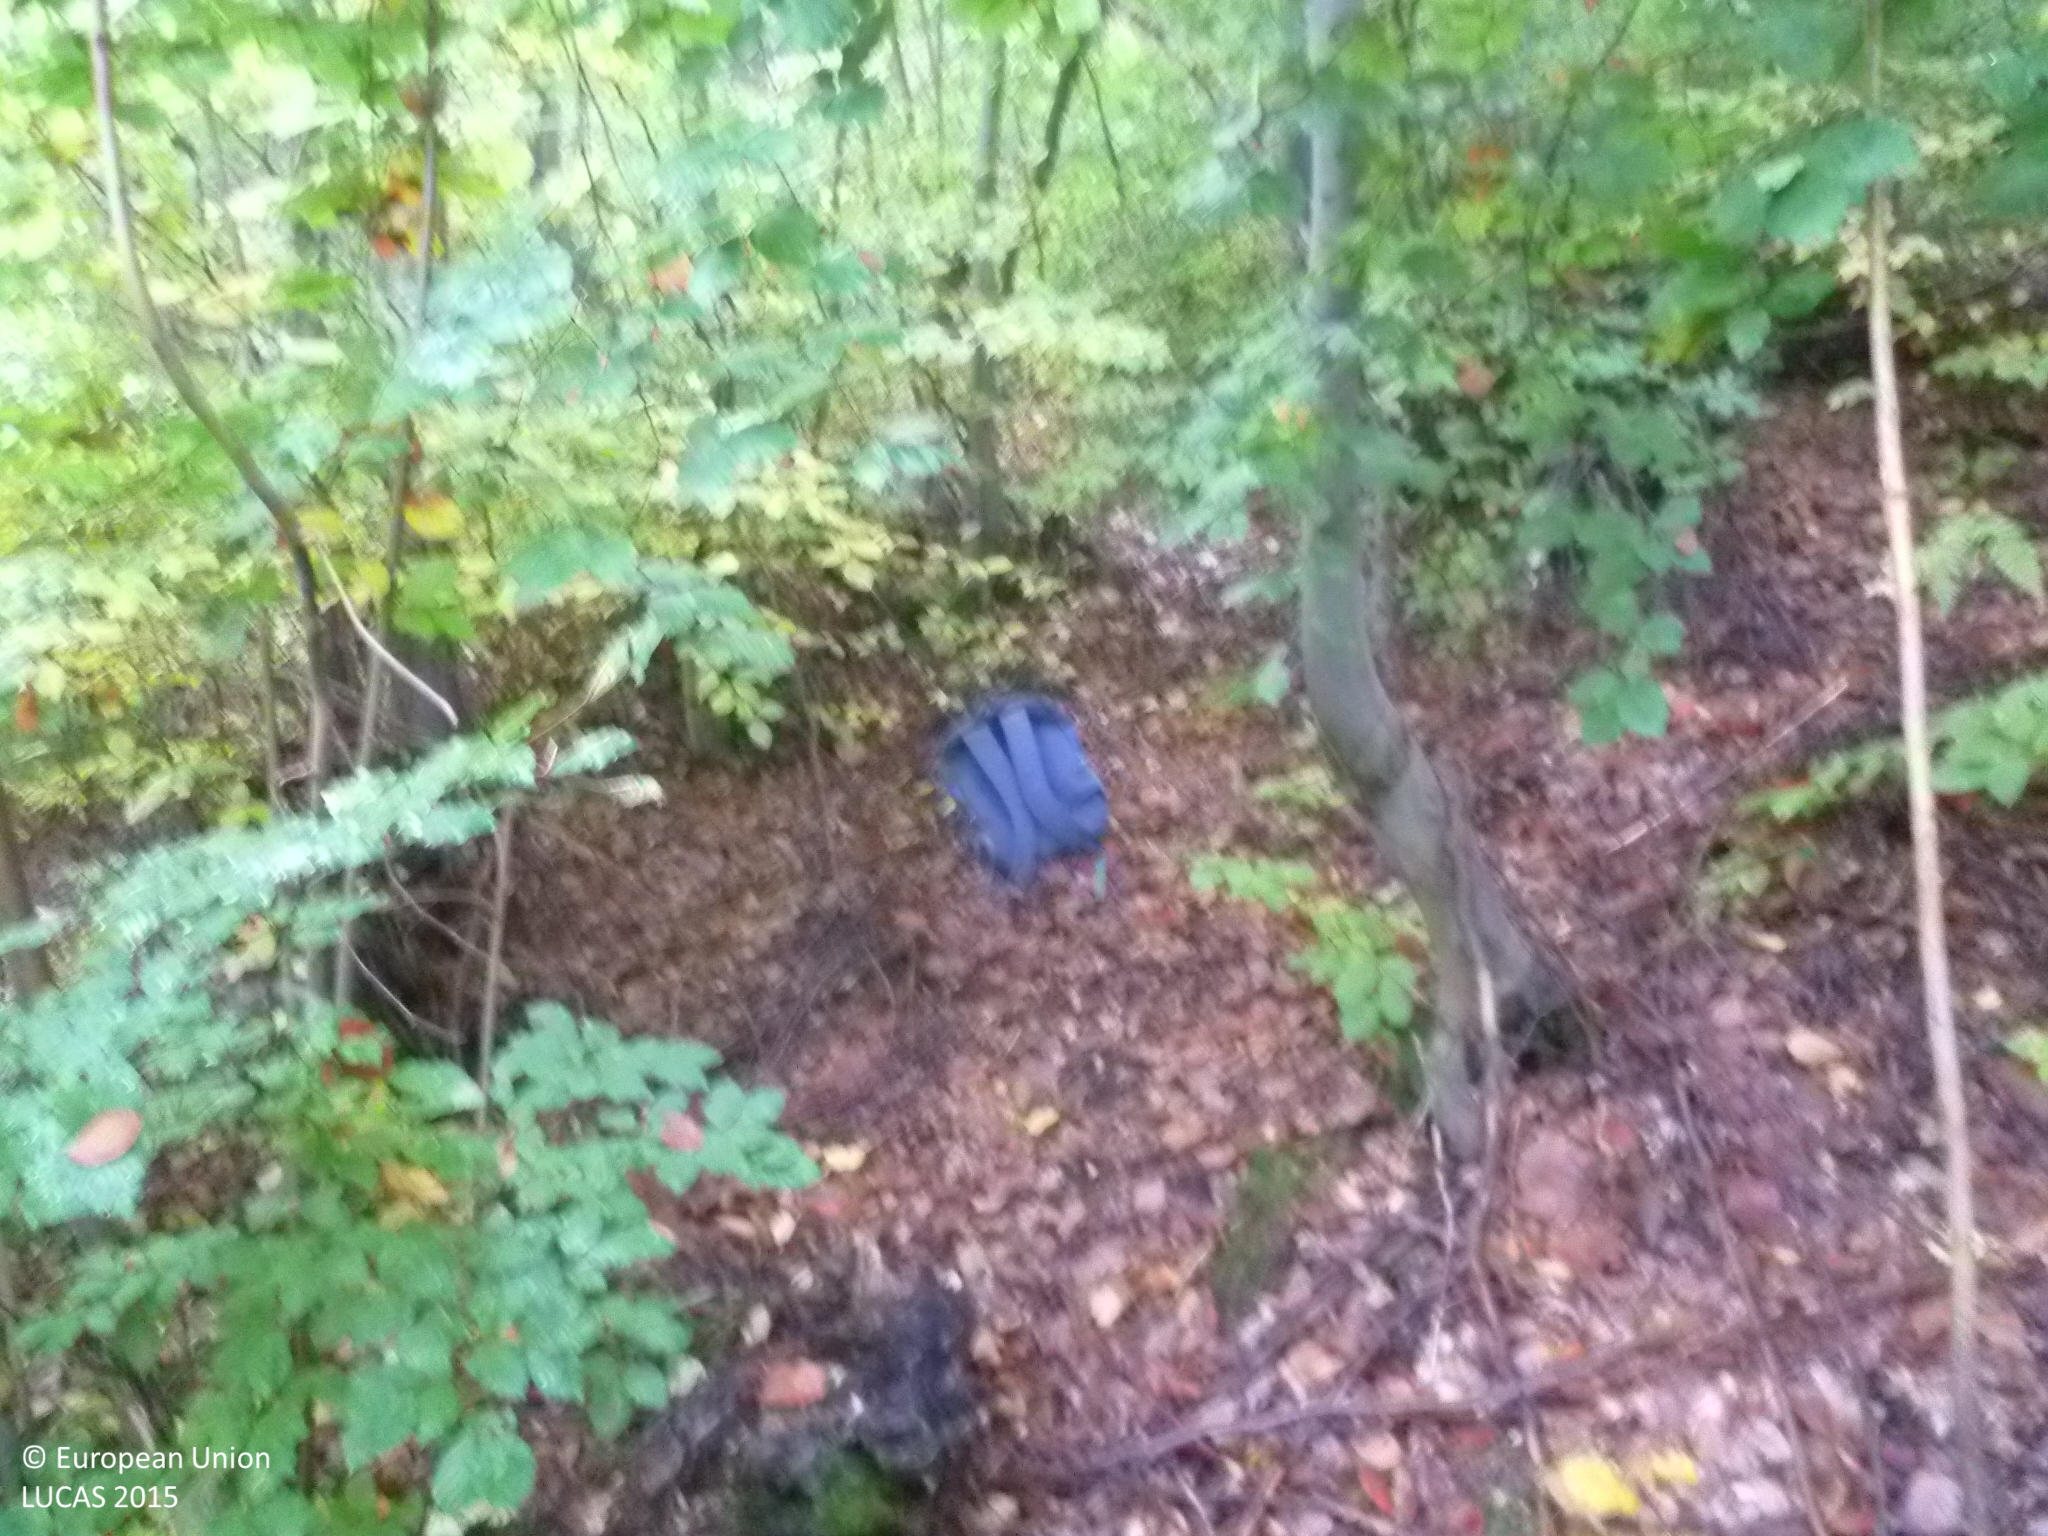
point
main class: Woodland
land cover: Broadleaved woodland
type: beech forest
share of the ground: > 75 %
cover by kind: broadleaved forest trees 80 %, unconsolidated bare surface 15 %, lichens and mosses 5 %
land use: Forestry
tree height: > 5 m
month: October
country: BG
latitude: 42.3543
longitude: 23.5956
